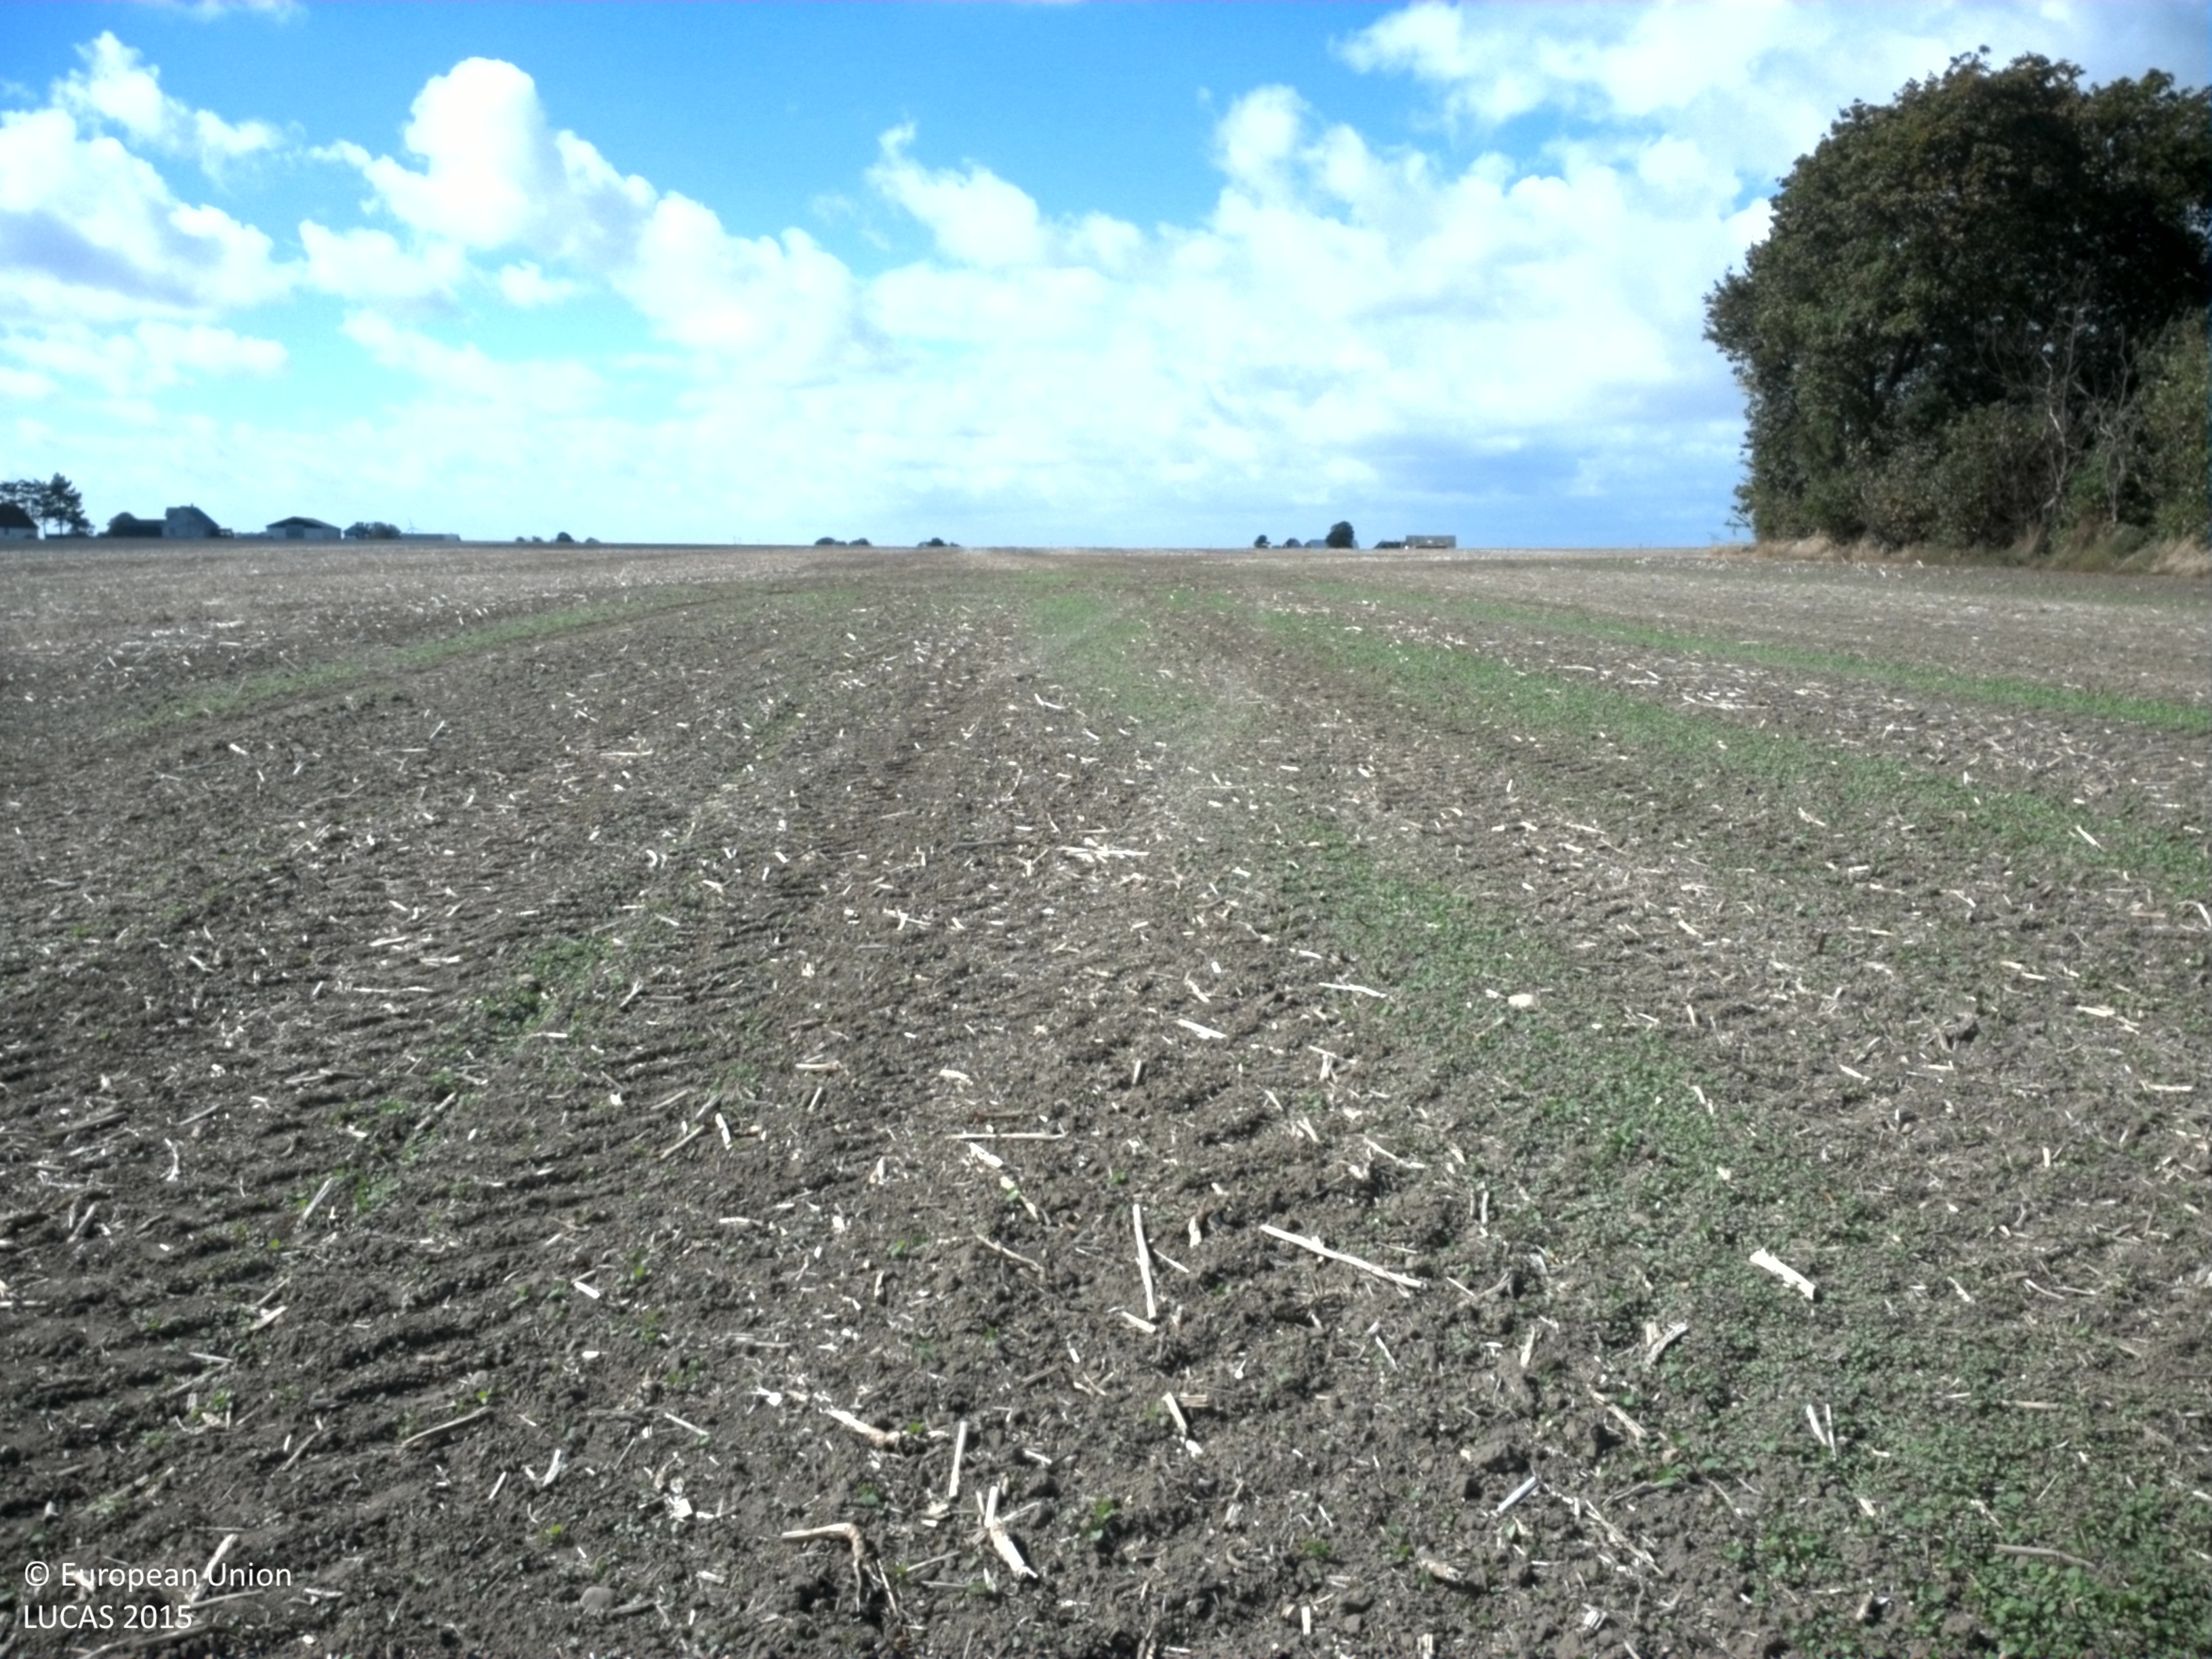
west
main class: Cropland
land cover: Rape and turnip rape
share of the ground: < 10 %
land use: Agriculture (excluding fallow land and kitchen gardens)
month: September
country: SE
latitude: 55.4893
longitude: 14.1927
